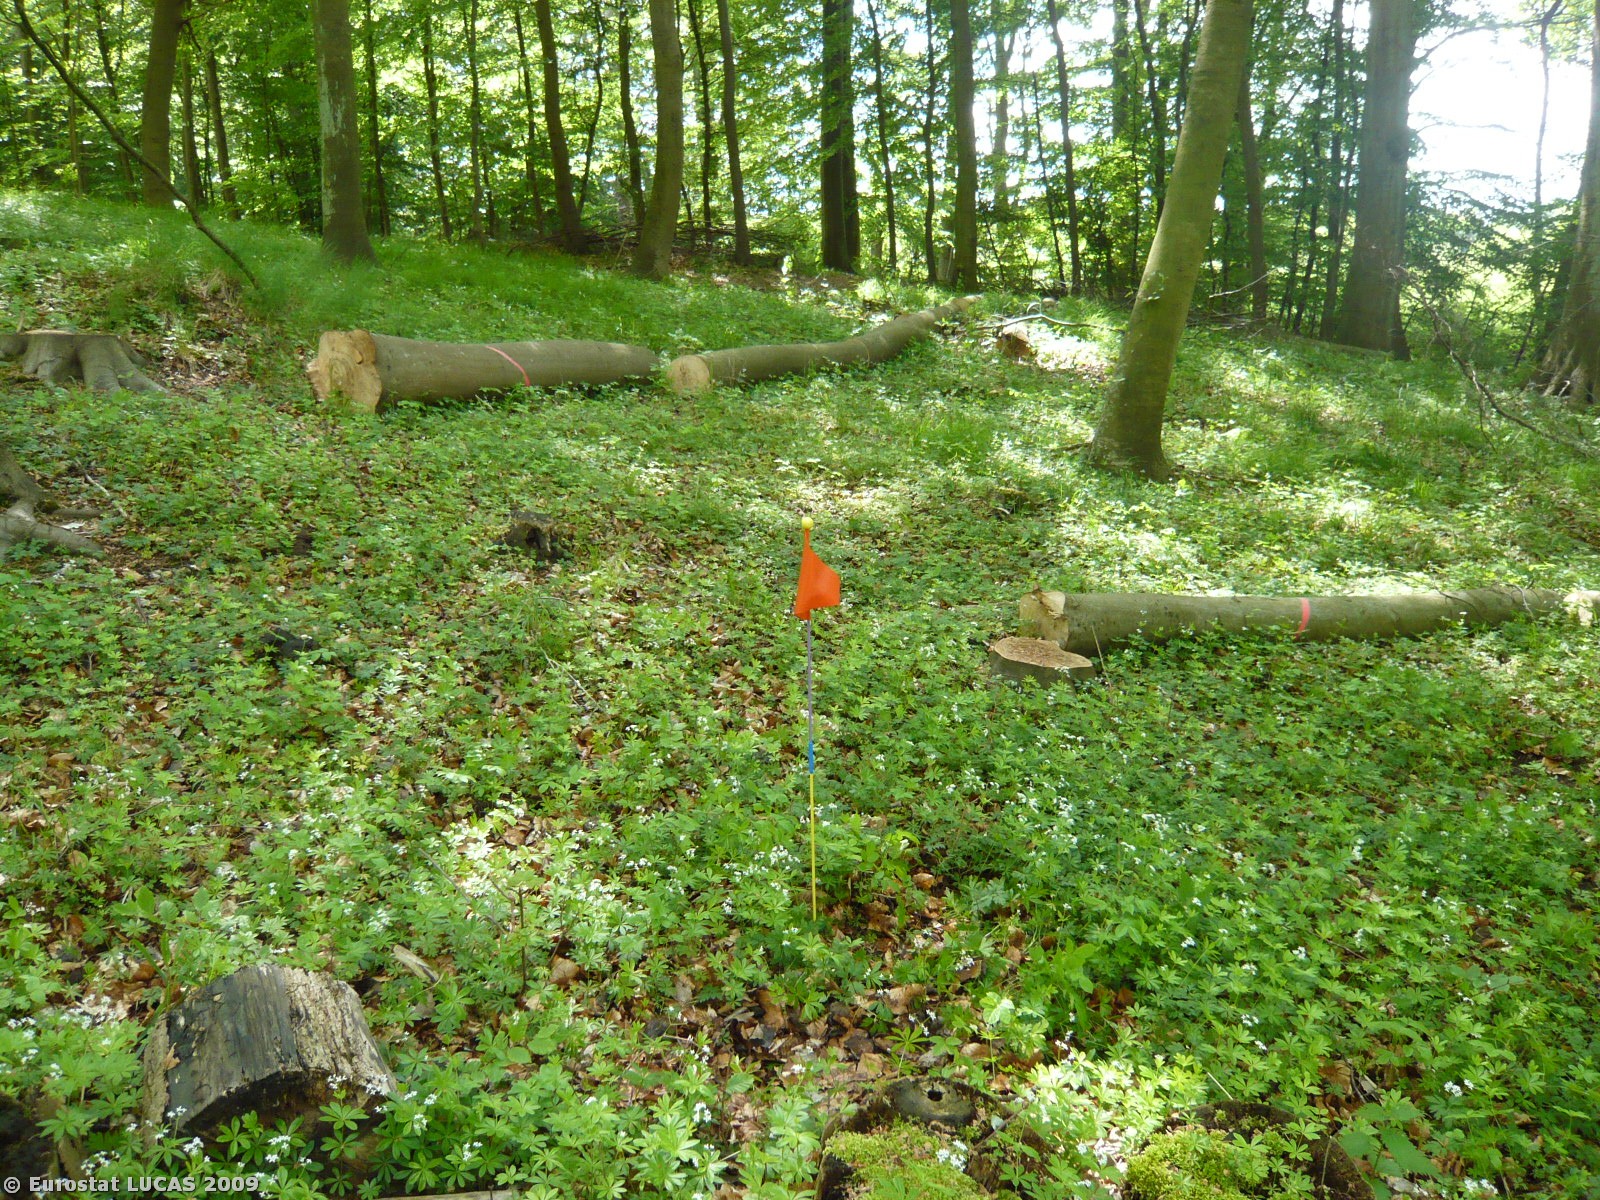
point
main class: Woodland
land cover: Broadleaved woodland
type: mesophytic deciduous forest
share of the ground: > 75 %
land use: Forestry
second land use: Amenities, museums, leisure
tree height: > 5 m
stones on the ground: < 10 %
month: May
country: DK
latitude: 55.6340
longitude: 11.9204
